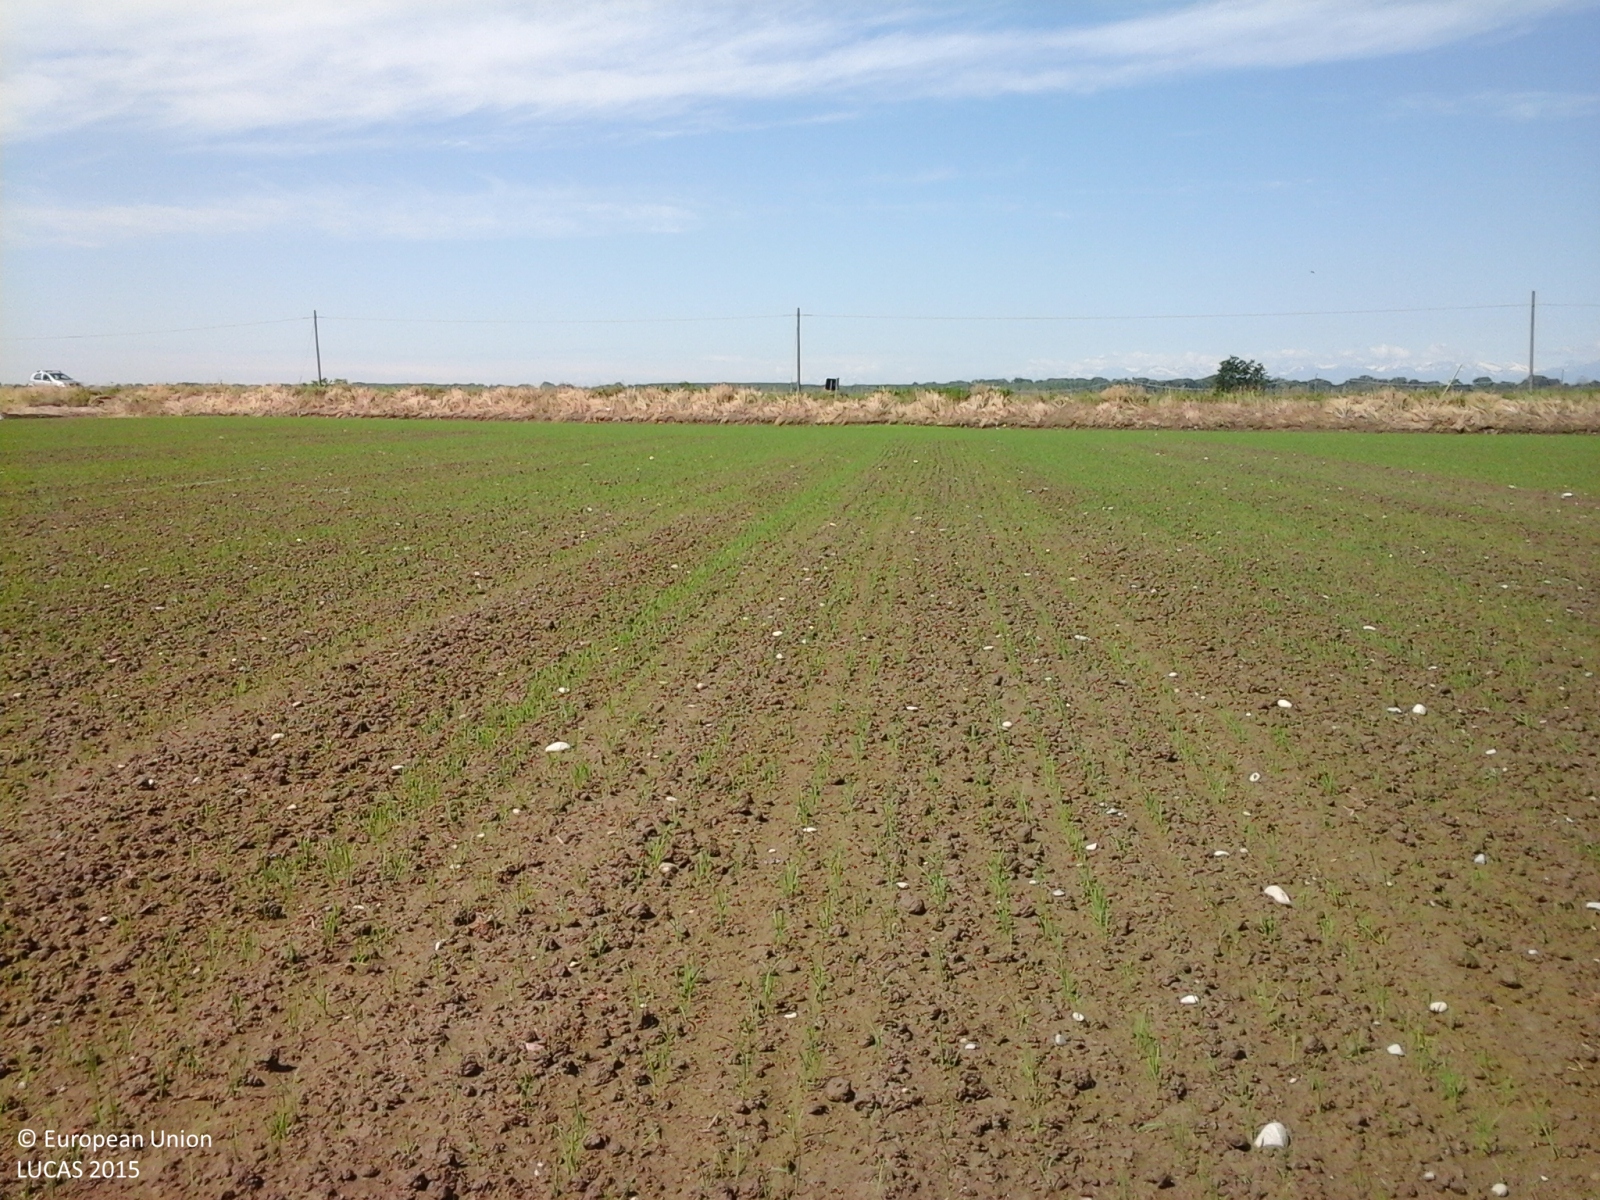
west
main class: Cropland
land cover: Rice
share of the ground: < 10 %
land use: Agriculture (excluding fallow land and kitchen gardens)
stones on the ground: < 10 %
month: May
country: IT
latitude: 45.4207
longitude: 8.4307
